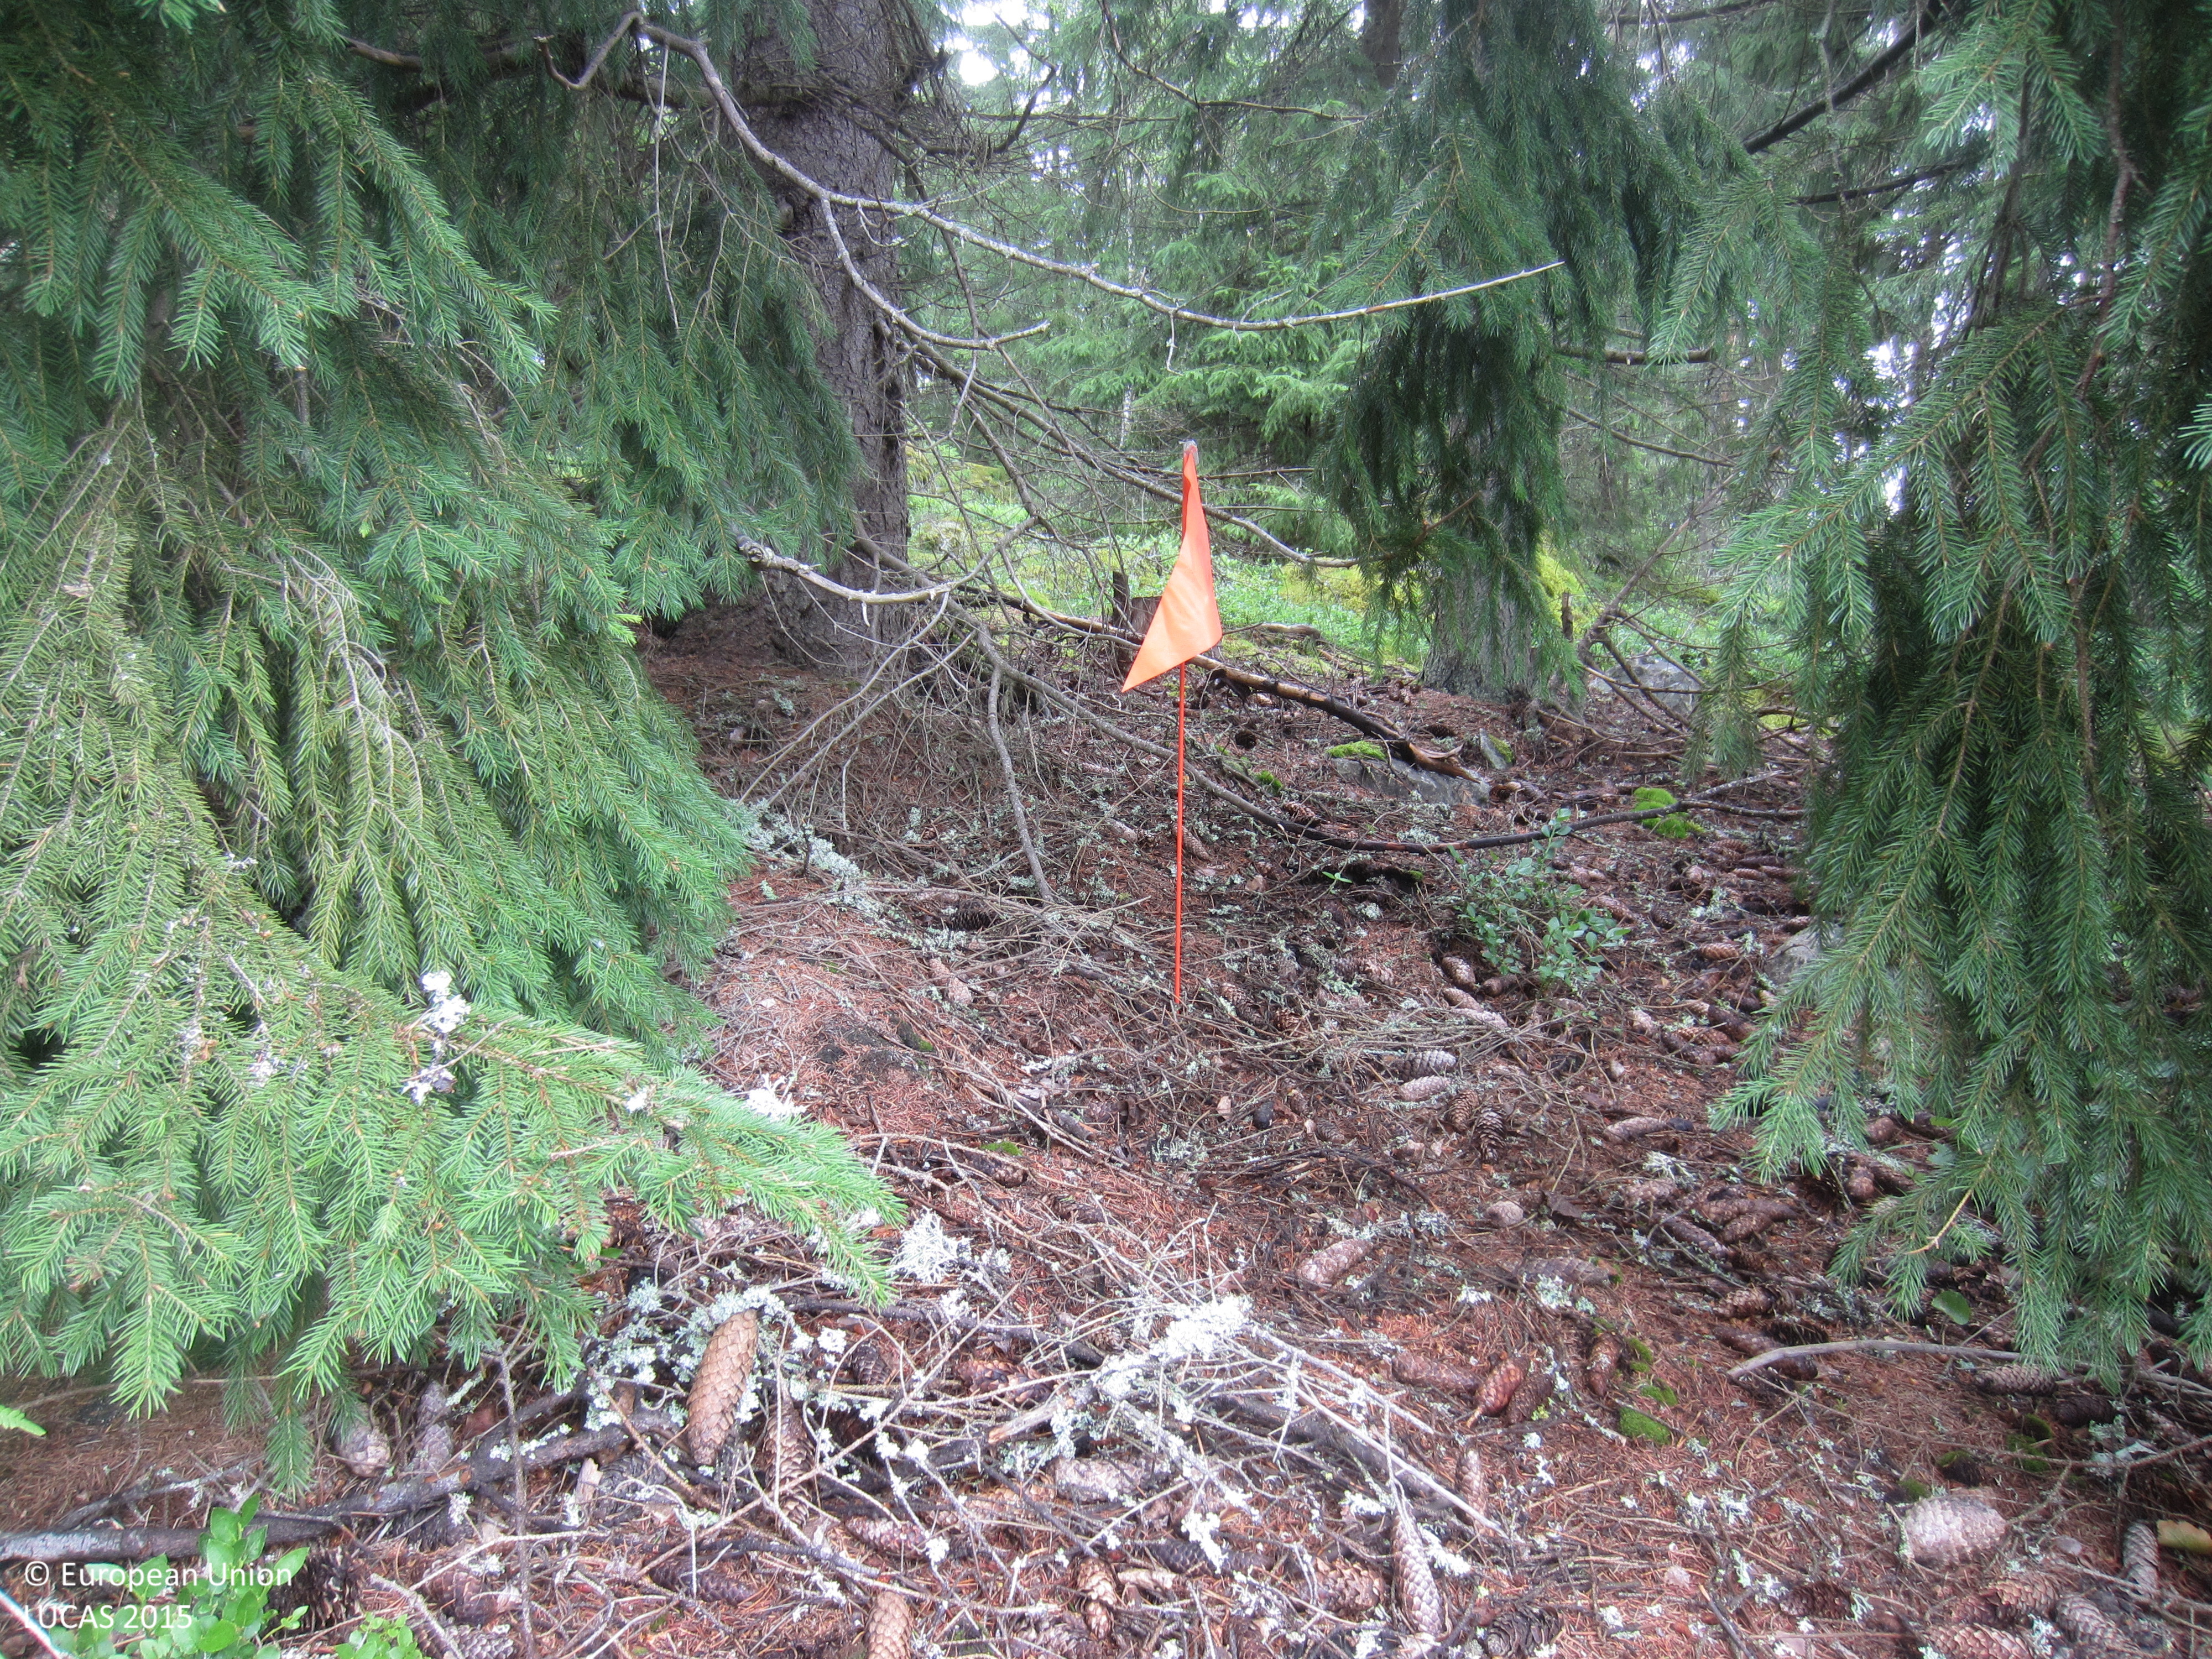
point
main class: Woodland
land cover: Spruce dominated coniferous woodland
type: boreal forest
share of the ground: 50 - 75 %
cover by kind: coniferous forest trees 70 %, lichens and mosses 25 %, broadleaved forest trees 5 %
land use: Forestry
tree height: > 5 m
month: July
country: SE
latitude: 59.8456
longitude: 16.9705
